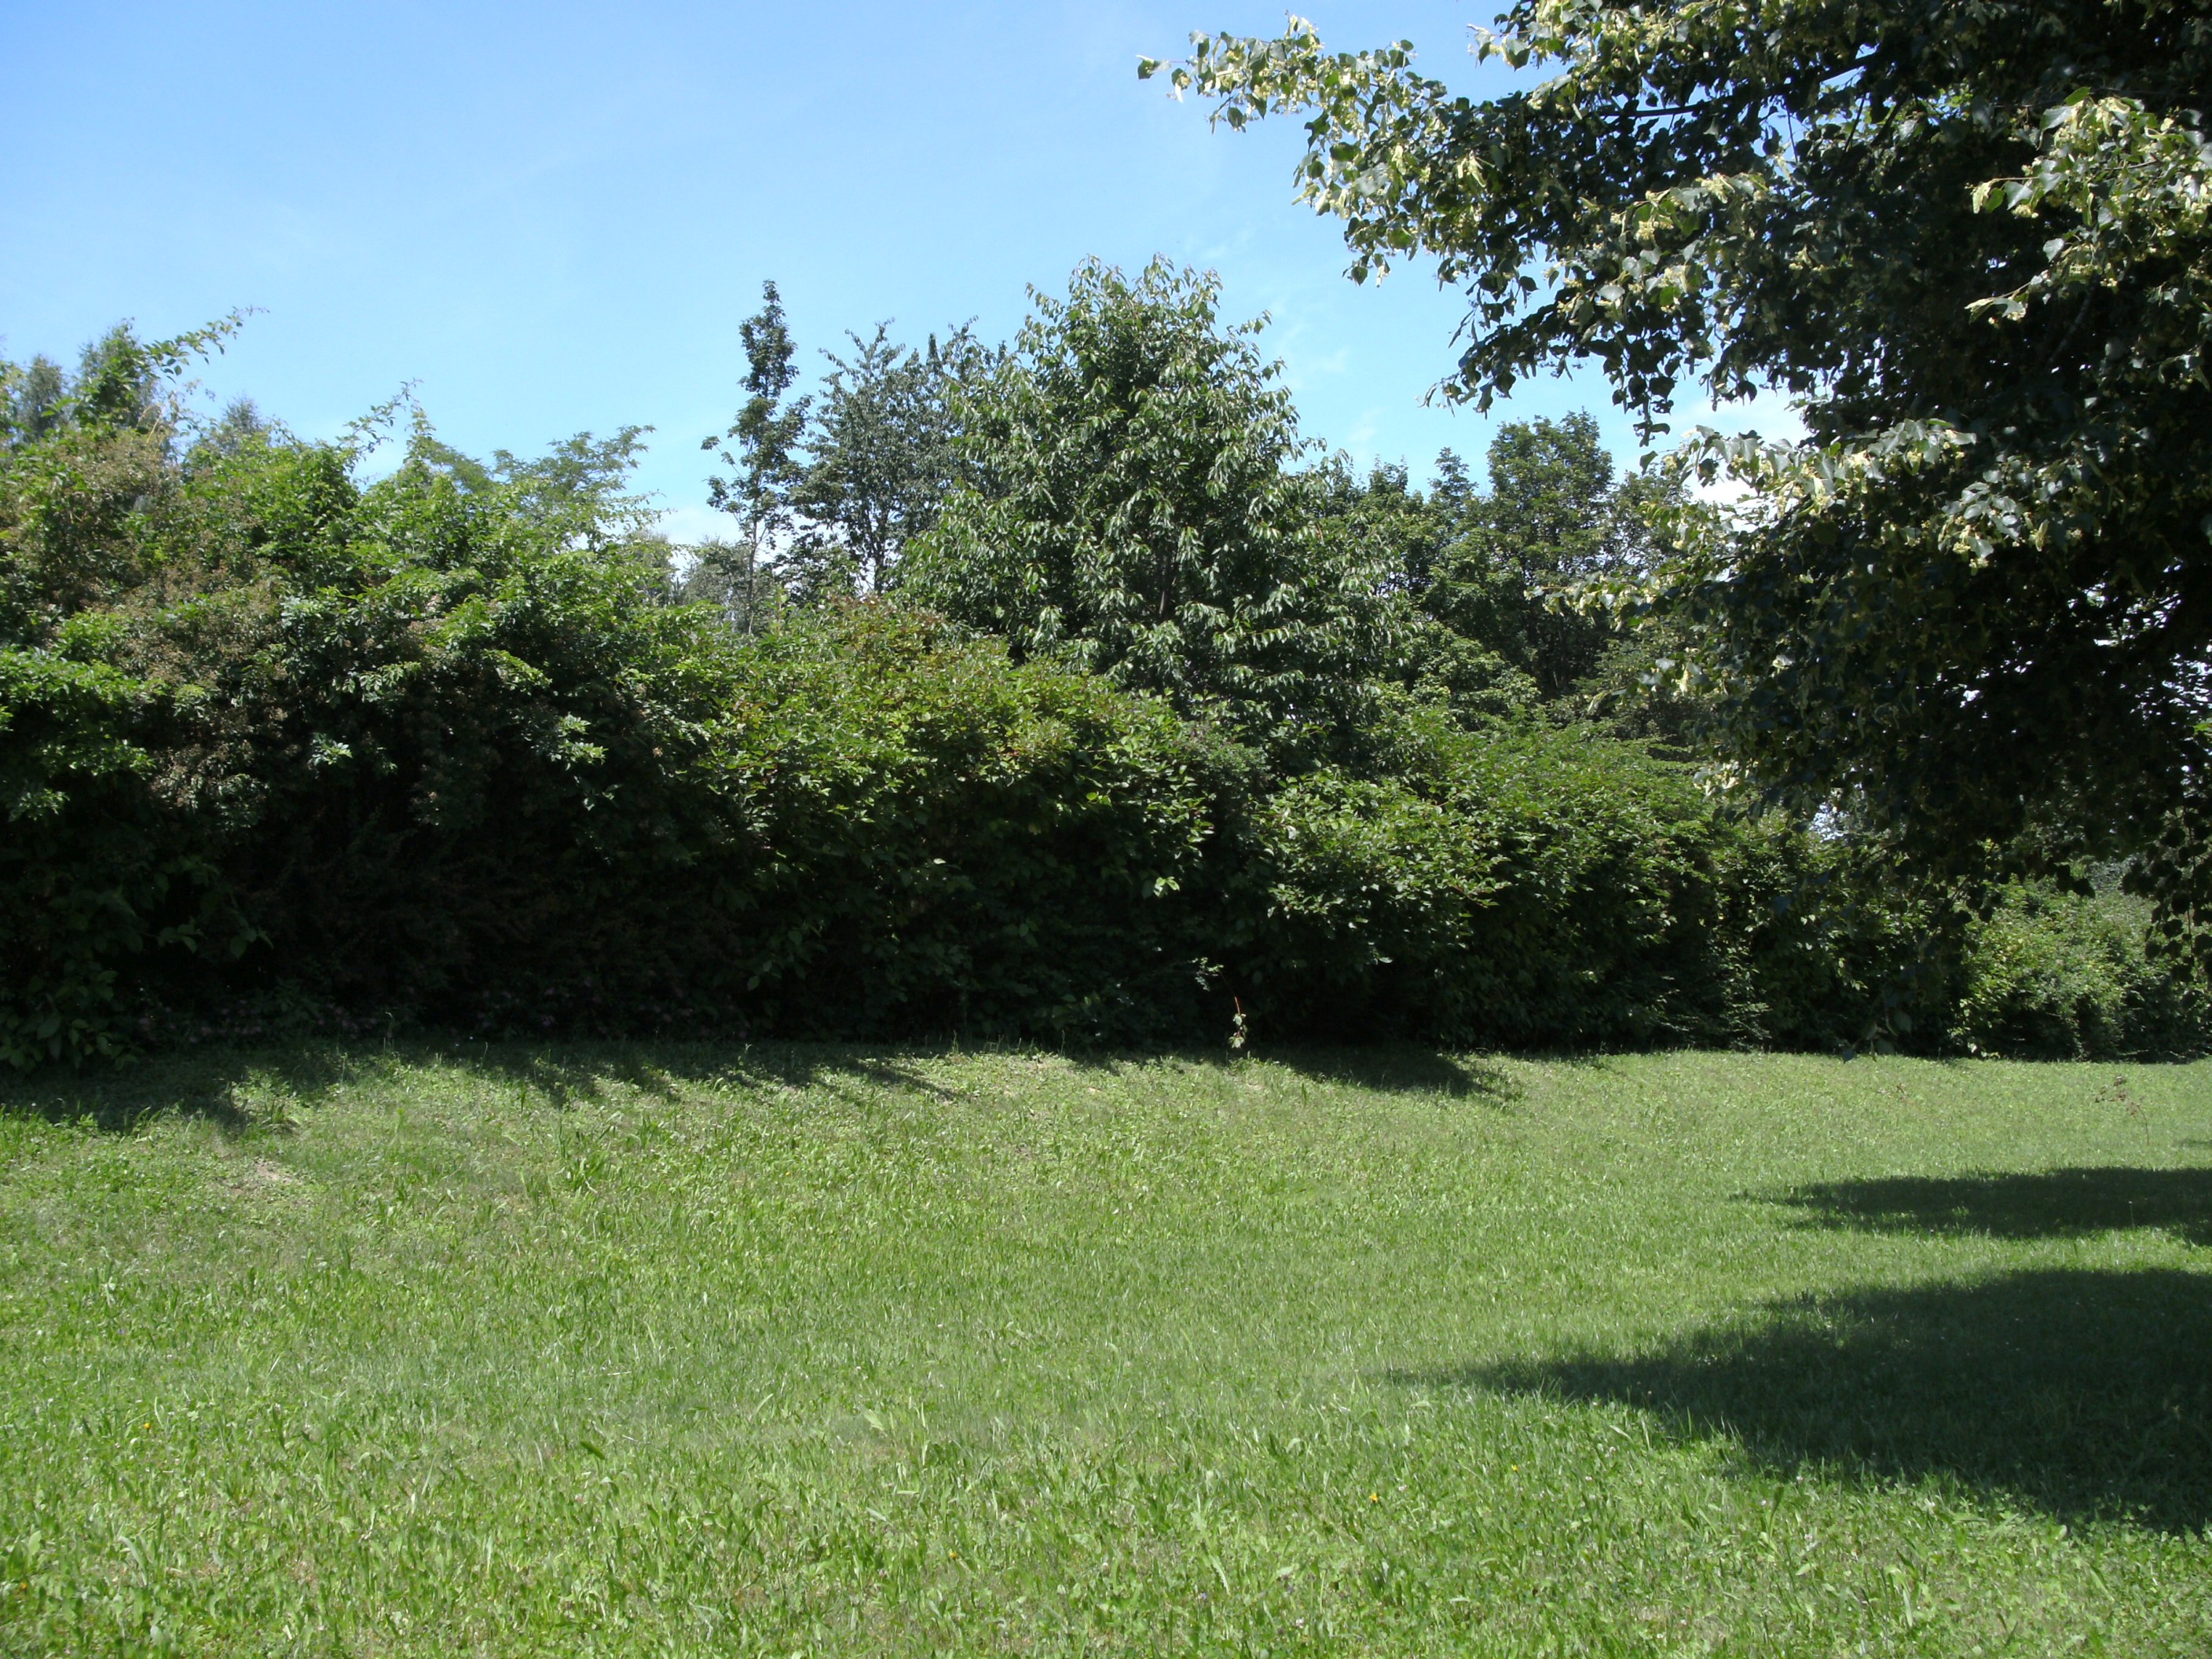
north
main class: Grassland
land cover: Grassland with sparse tree/shrub cover
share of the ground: > 75 %
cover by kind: herbaceous plants 95 %, broadleaved forest trees 5 %
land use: Residential
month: June
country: AT
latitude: 48.2118
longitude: 13.8080
